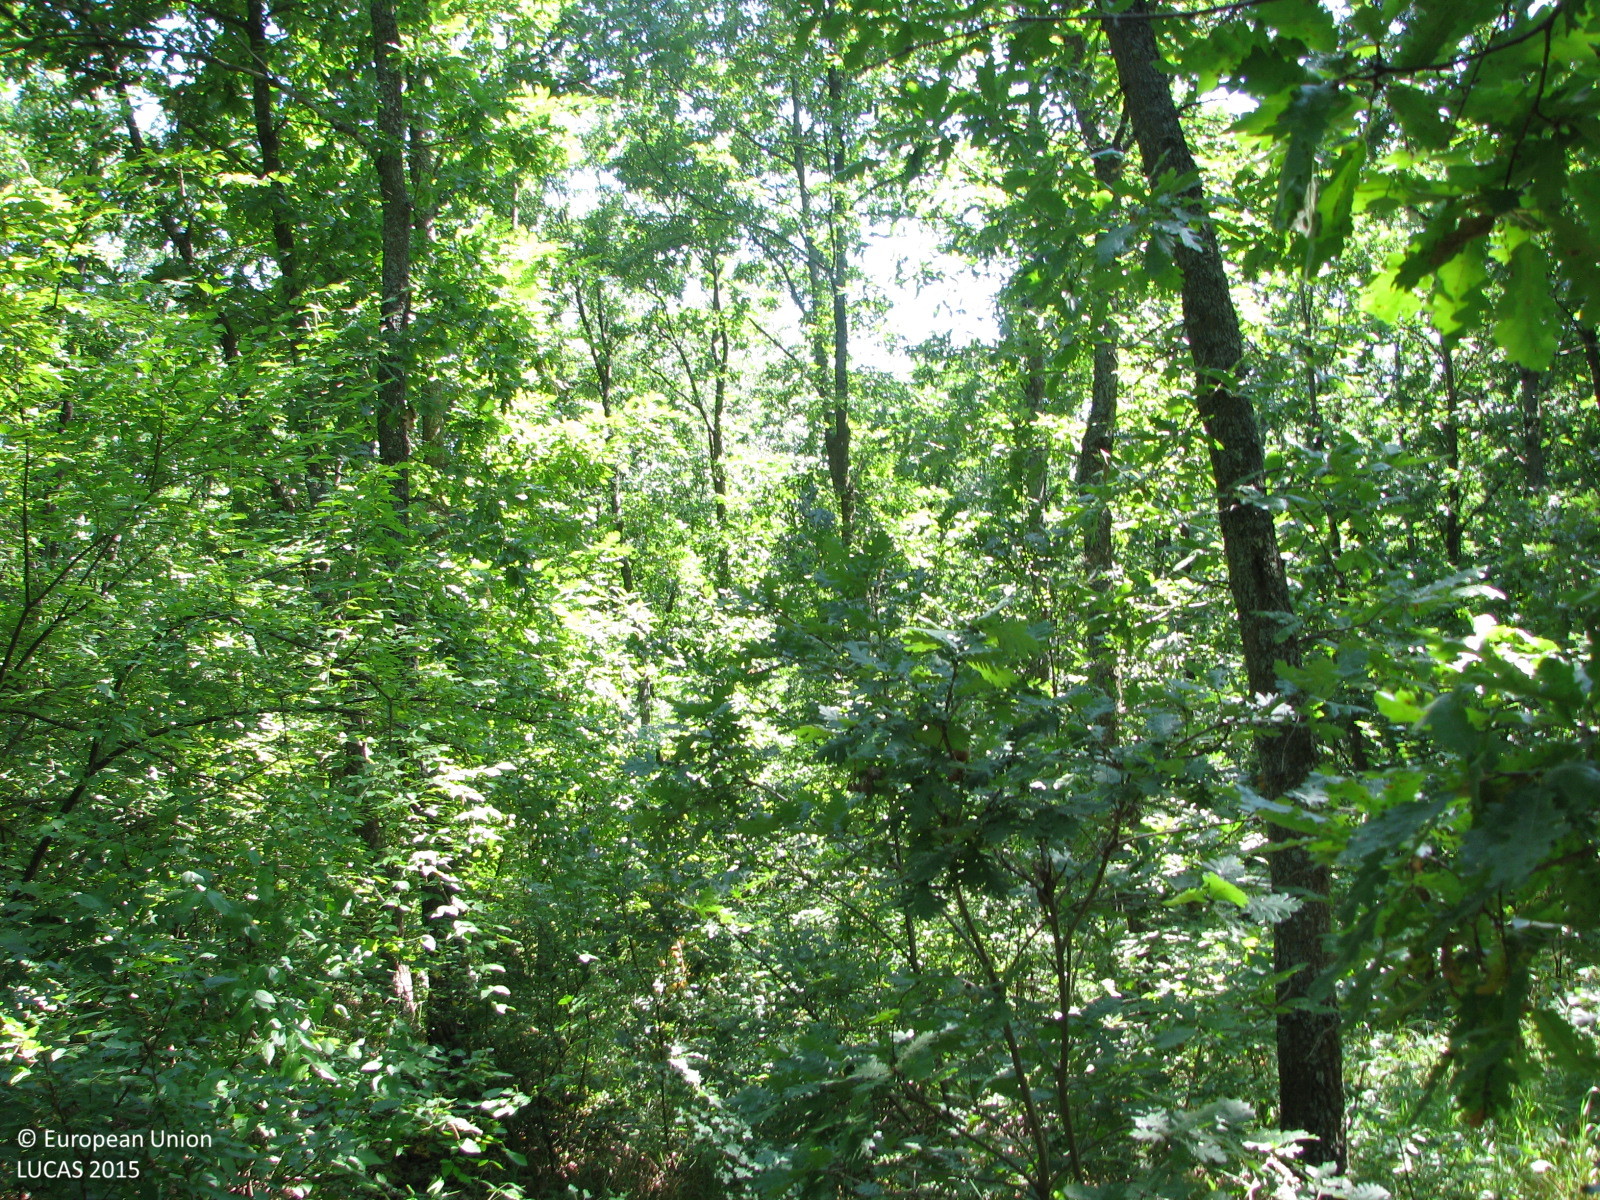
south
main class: Woodland
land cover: Broadleaved woodland
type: thermophilous deciduous forest
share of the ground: 50 - 75 %
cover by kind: broadleaved forest trees 60 %, herbaceous plants 30 %, shrubs 10 %
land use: Forestry
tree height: > 5 m
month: July
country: BG
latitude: 42.2631
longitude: 26.8391
